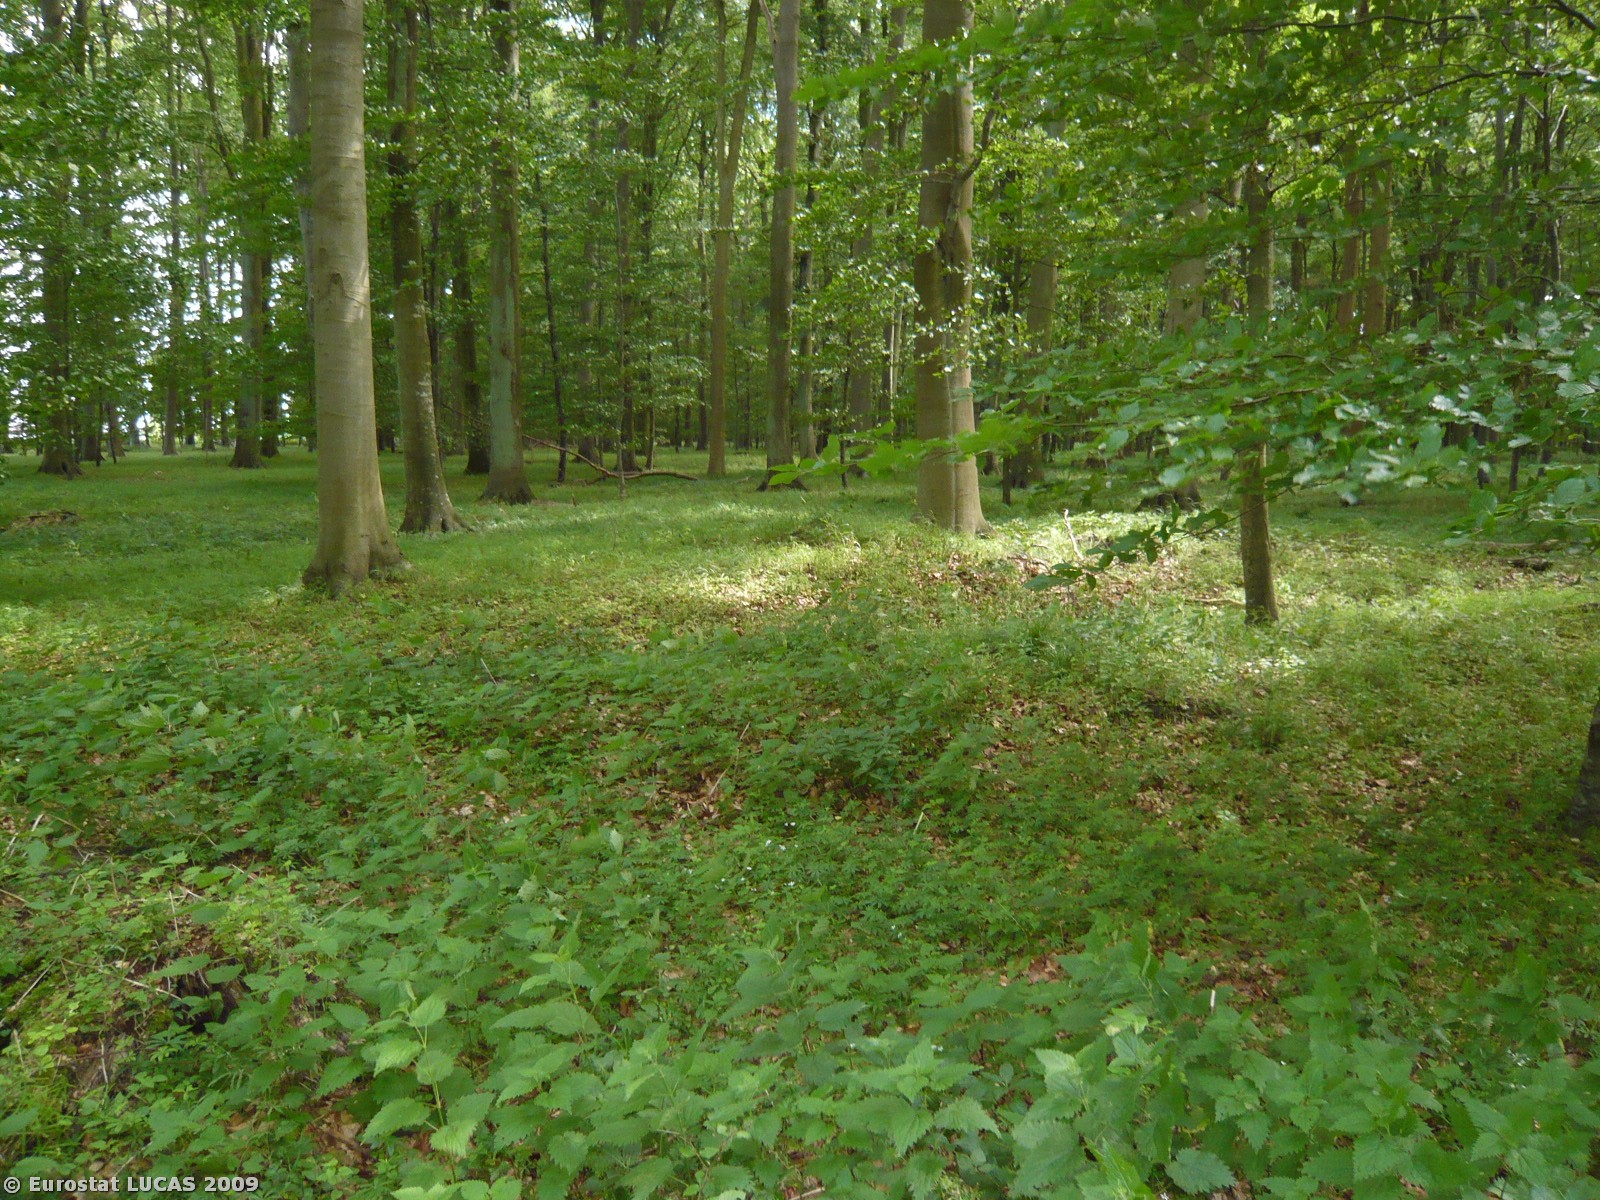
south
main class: Woodland
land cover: Broadleaved woodland
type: mesophytic deciduous forest
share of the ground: > 75 %
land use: Forestry
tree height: > 5 m
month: June
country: DK
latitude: 54.8686
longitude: 11.3235
